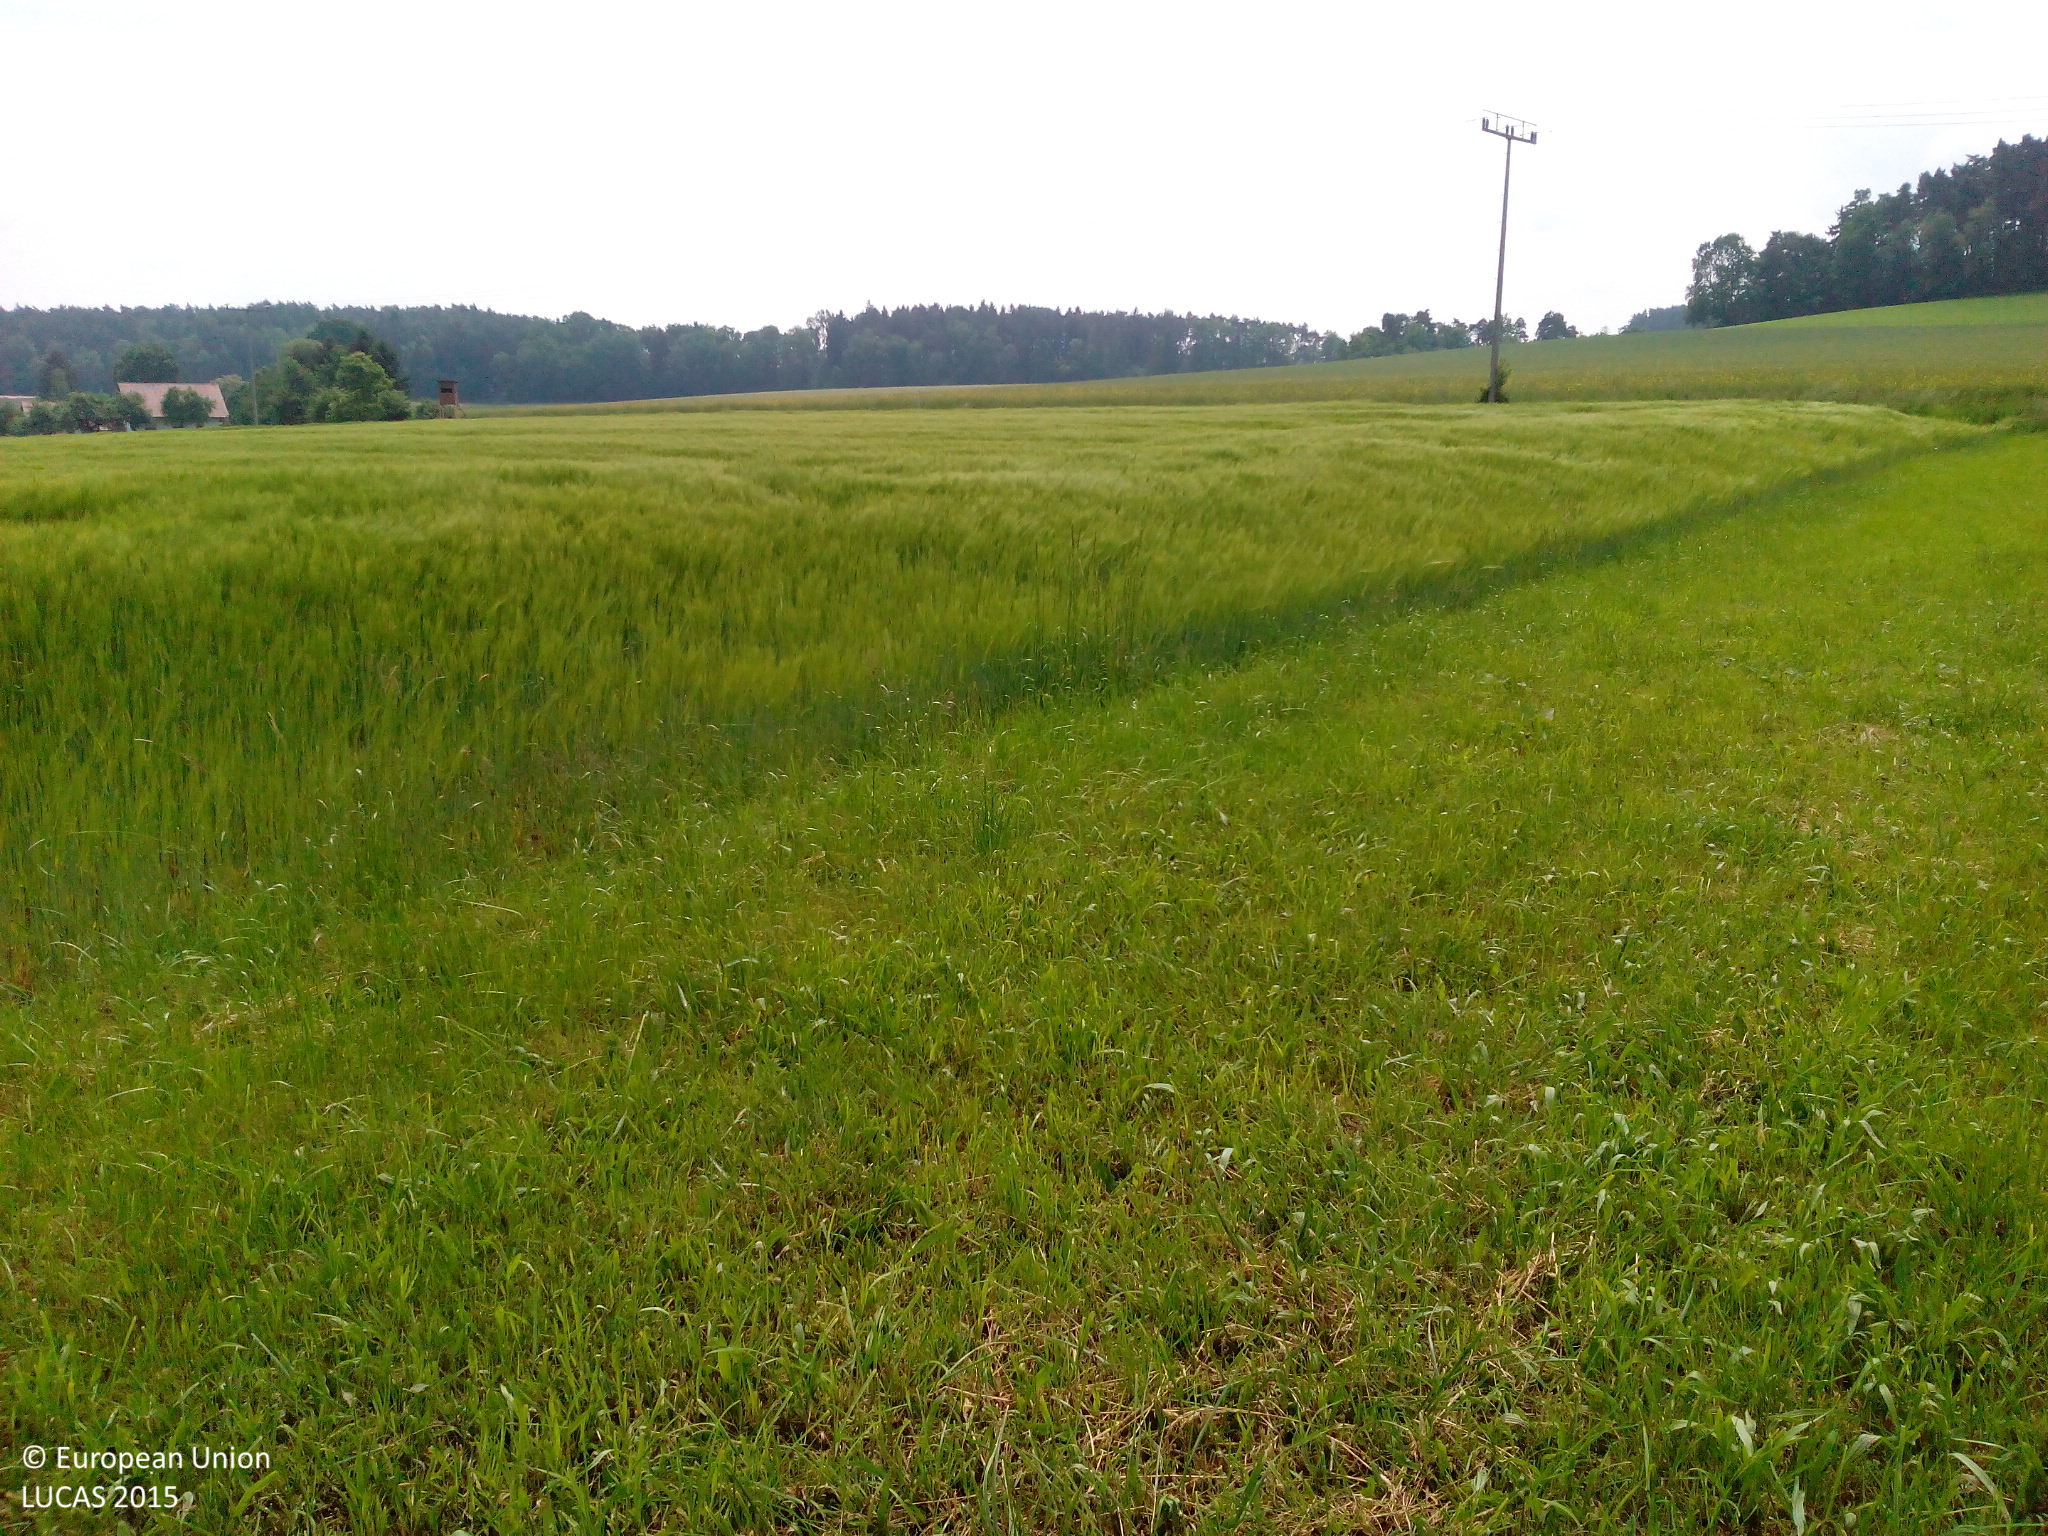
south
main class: Grassland
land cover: Grassland without tree/shrub cover
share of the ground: > 75 %
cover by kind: herbaceous plants 95 %, unconsolidated bare surface 5 %
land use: Agriculture (excluding fallow land and kitchen gardens)
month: May
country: DE
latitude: 49.1395
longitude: 12.0966
